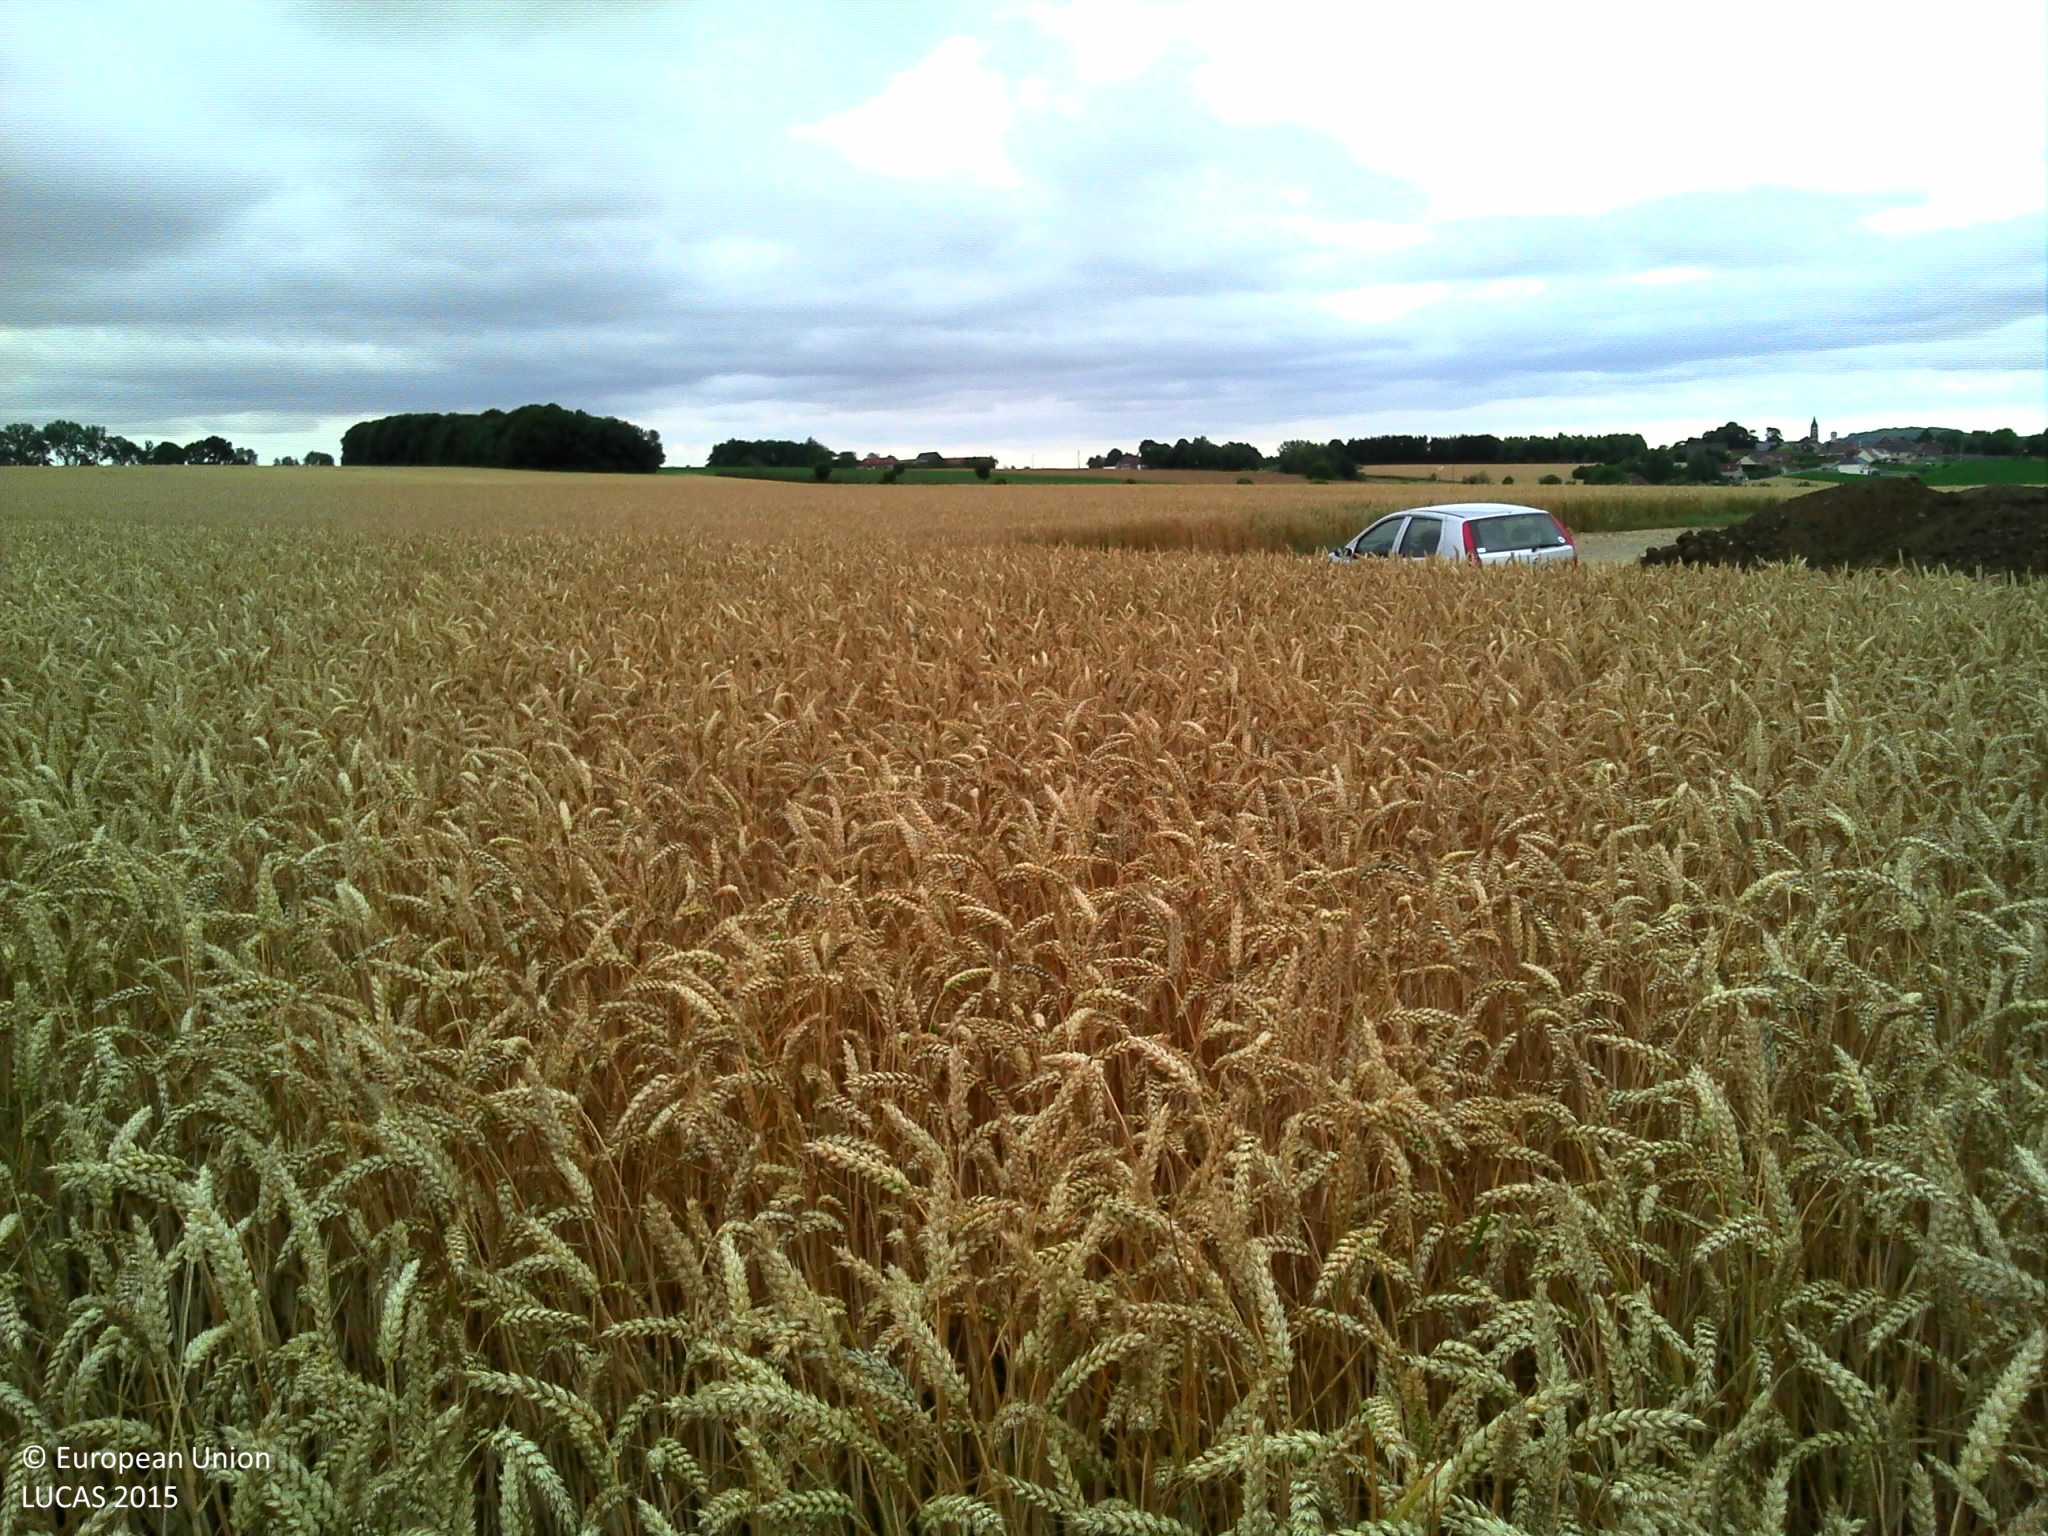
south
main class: Cropland
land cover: Common wheat
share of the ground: > 75 %
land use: Agriculture (excluding fallow land and kitchen gardens)
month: July
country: FR
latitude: 50.0723
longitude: 3.2147
